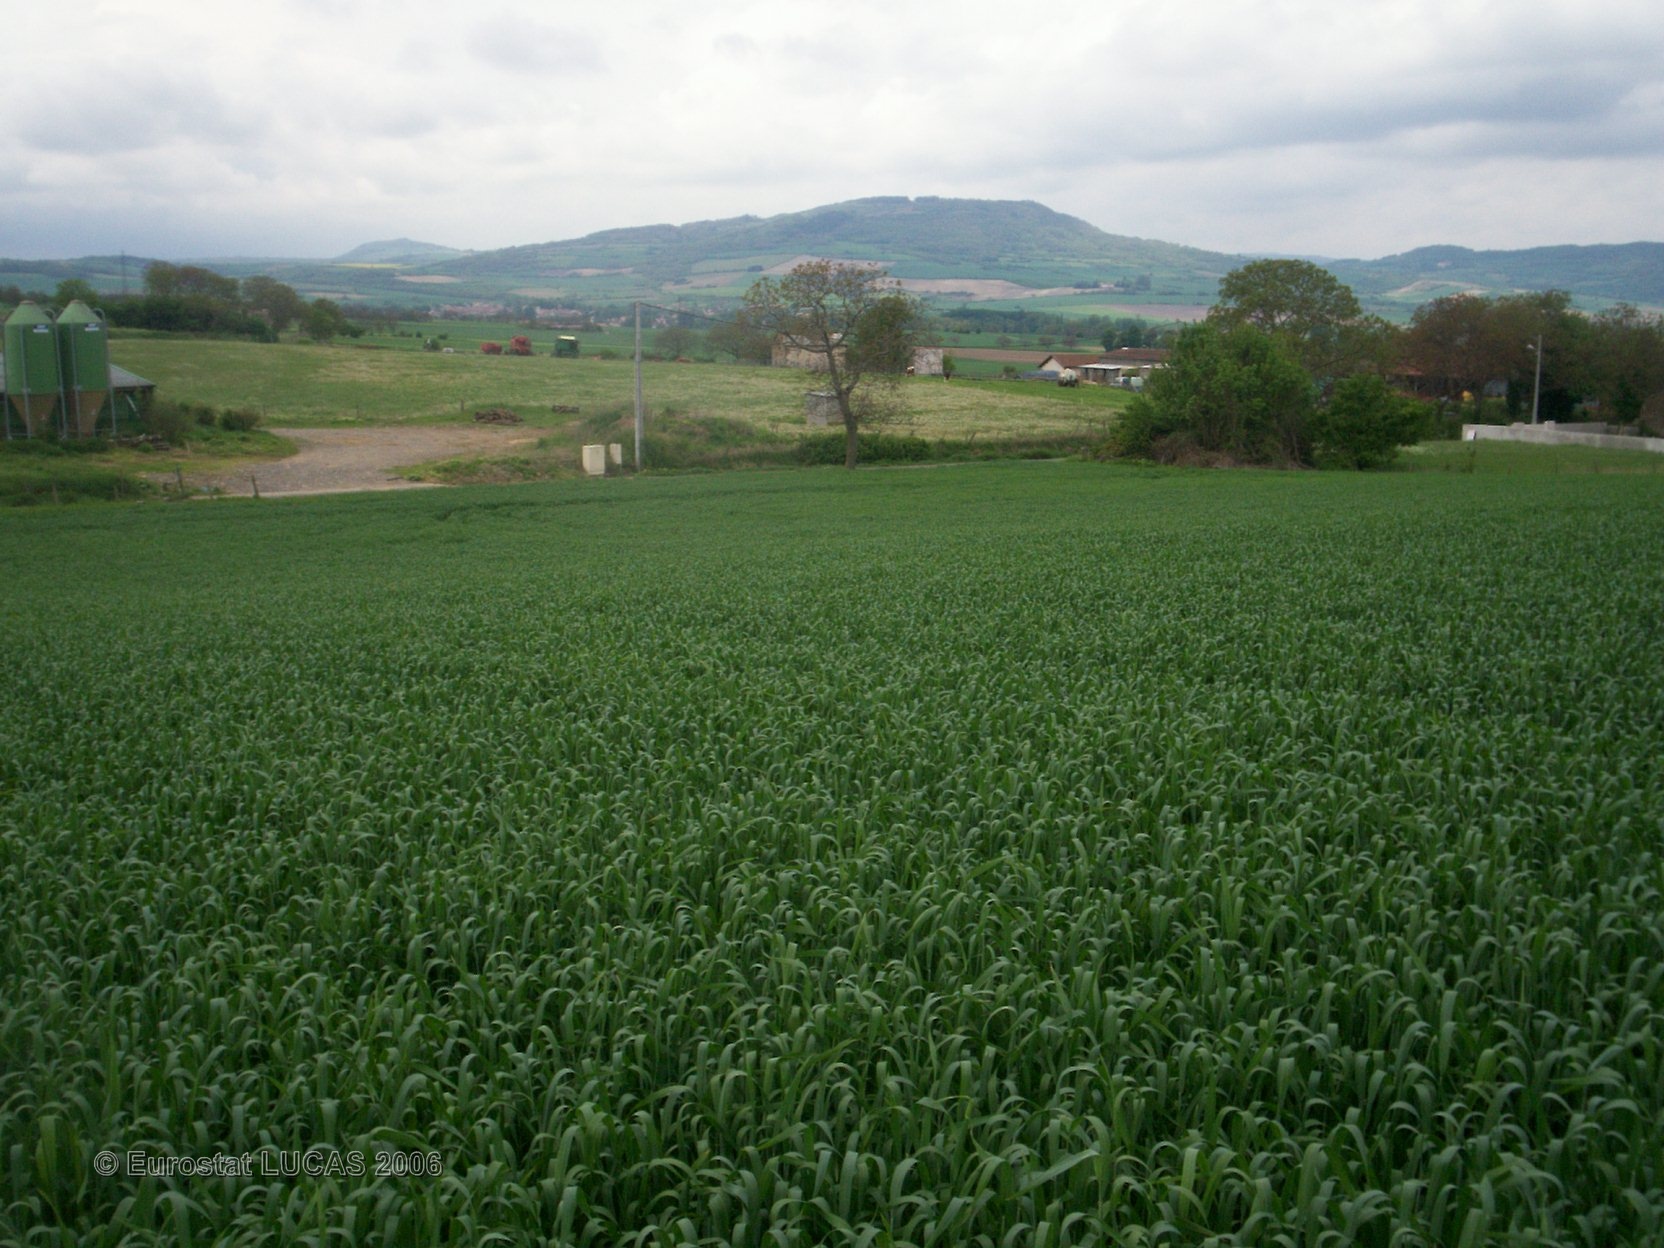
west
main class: Cropland
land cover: Common wheat
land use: Agriculture (excluding fallow land and kitchen gardens)
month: May
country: FR
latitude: 45.6279
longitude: 3.1895
